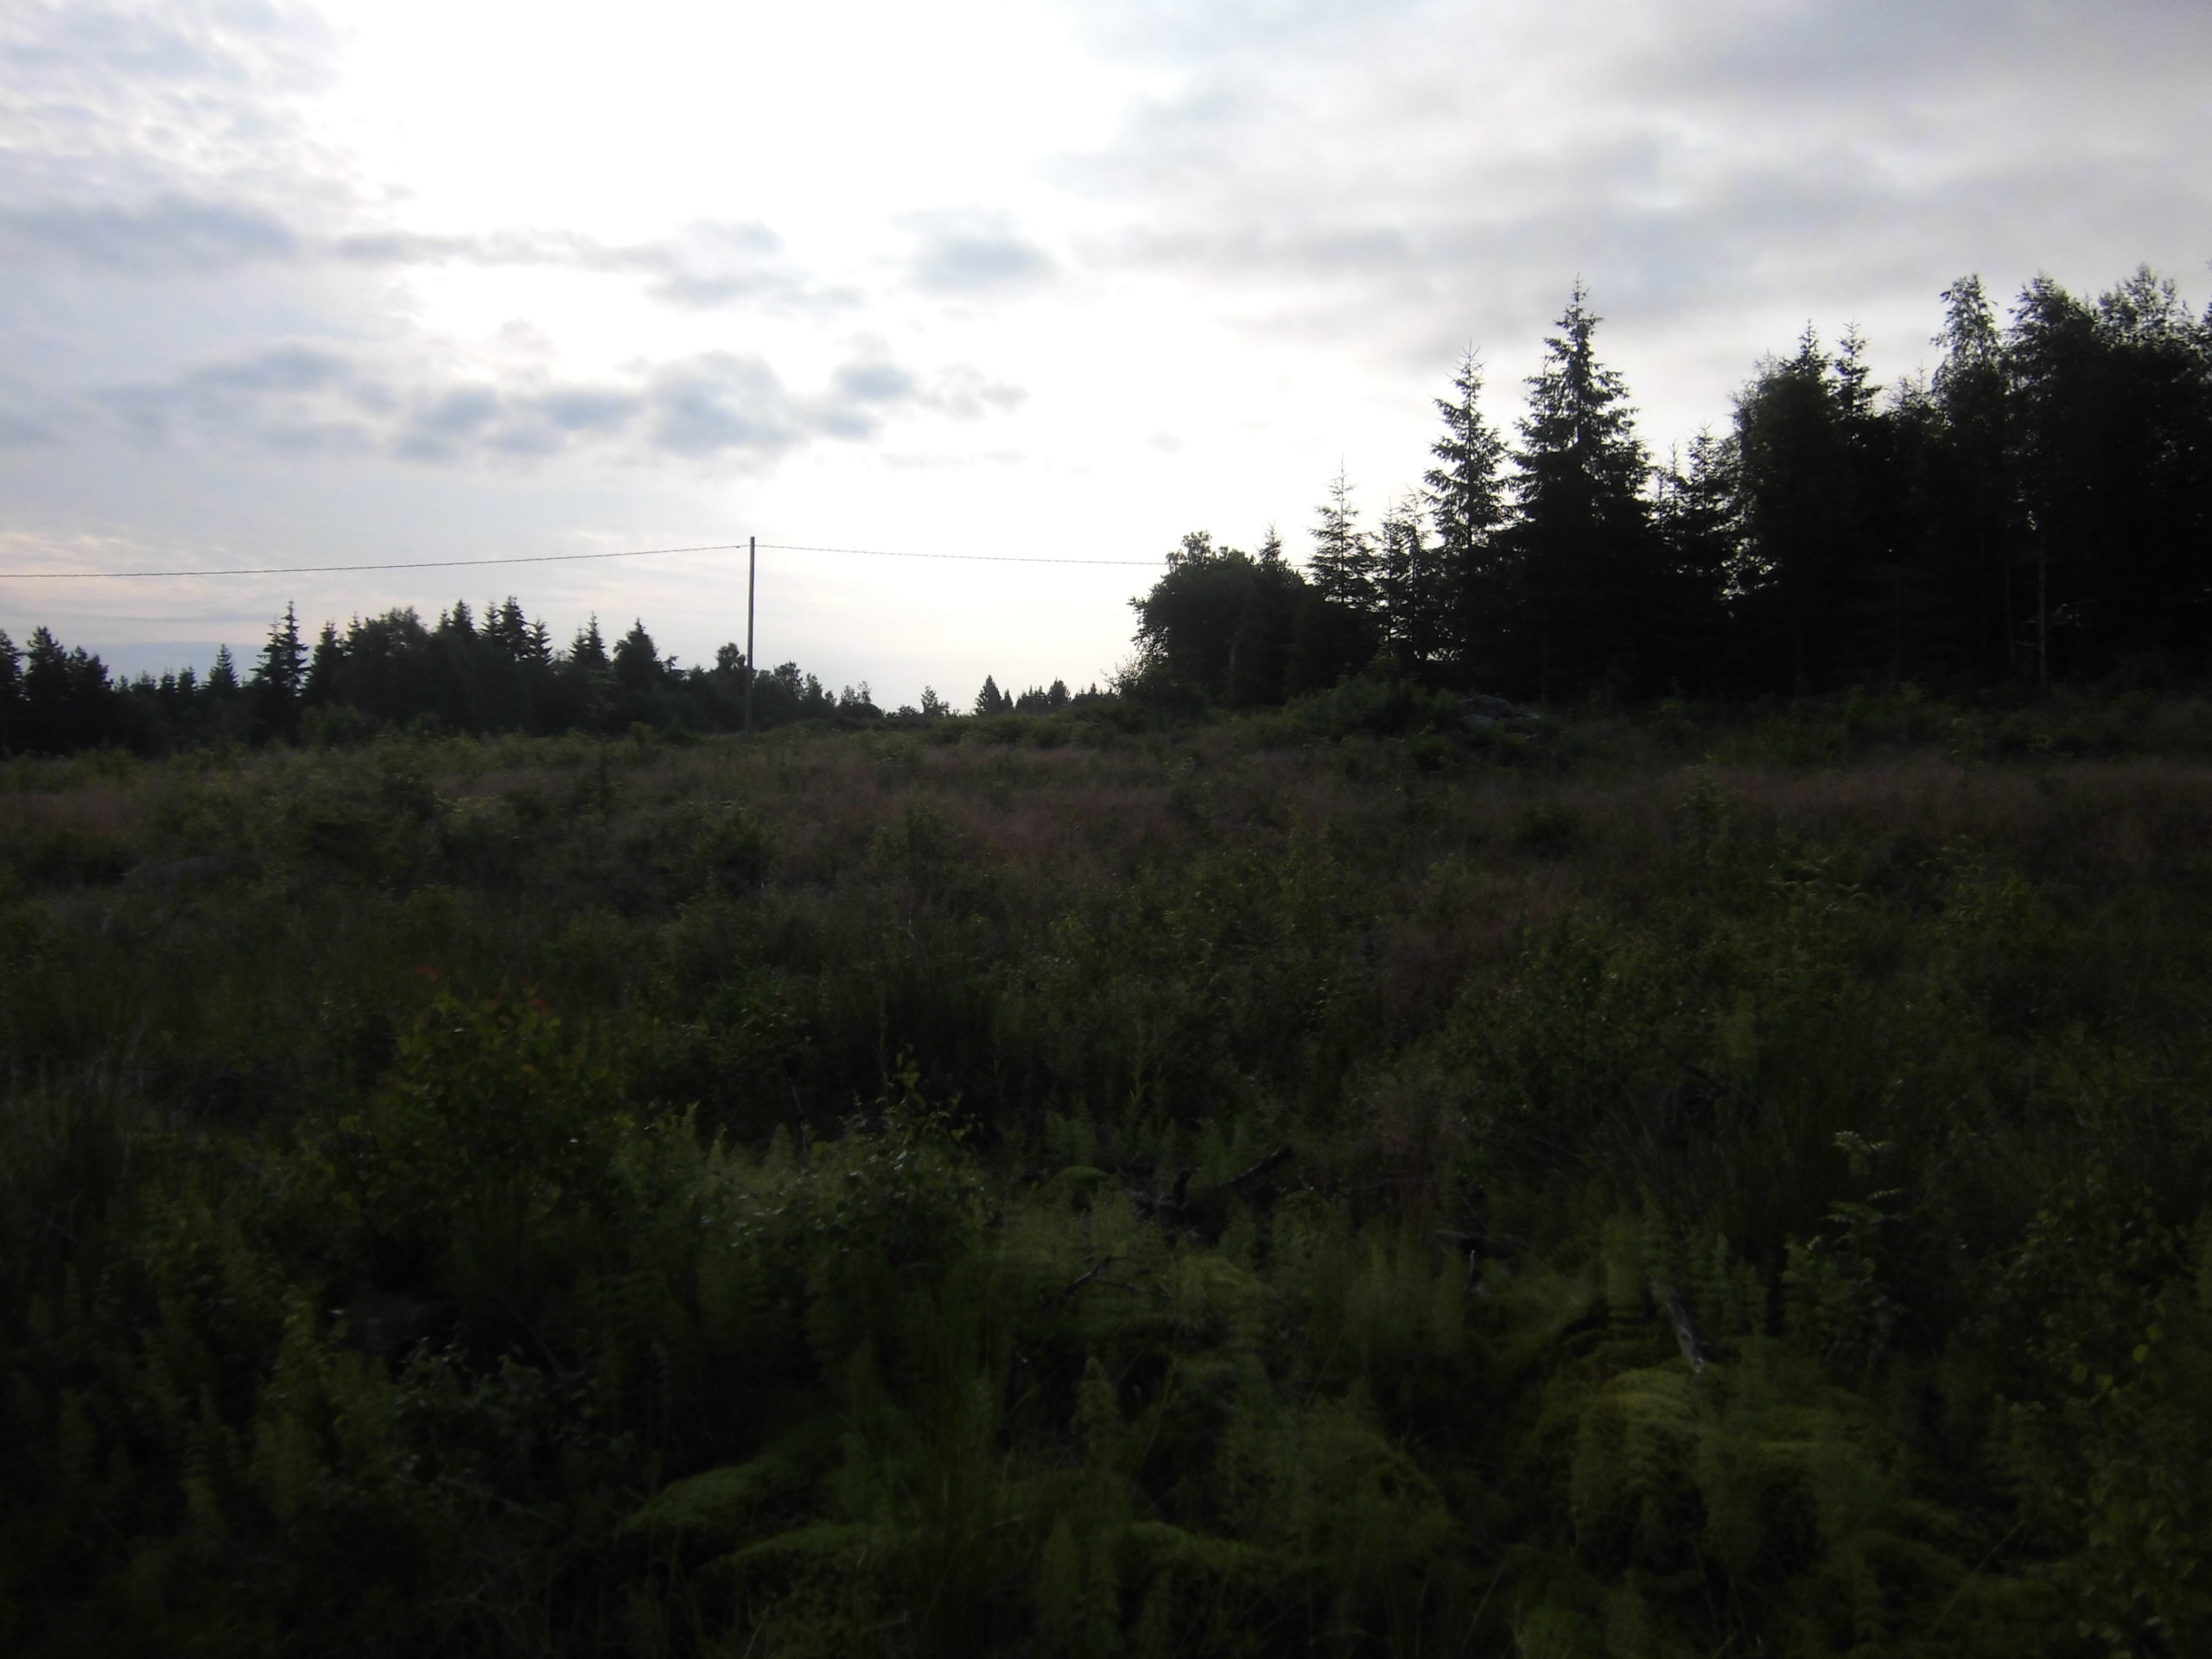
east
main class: Woodland
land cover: Pine dominated mixed woodland
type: boreal forest
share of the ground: 25 - 50 %
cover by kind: herbaceous plants 40 %, shrubs 25 %, broadleaved forest trees 15 %, coniferous forest trees 10 %, lichens and mosses 10 %
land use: Forestry
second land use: Amenities, museums, leisure
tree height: > 5 m
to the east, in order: Pine dominated mixed woodland; Broadleaved woodland; Grassland with sparse tree/shrub cover; Electric lines; Fences; Grassland with sparse tree/shrub cover; Fences; Paved roads, cycling and walking lanes; Spontaneously vegetated surfaces; Dry stone walls; Grassland without tree/shrub cover
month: July
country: SE
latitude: 57.3937
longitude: 14.8380
